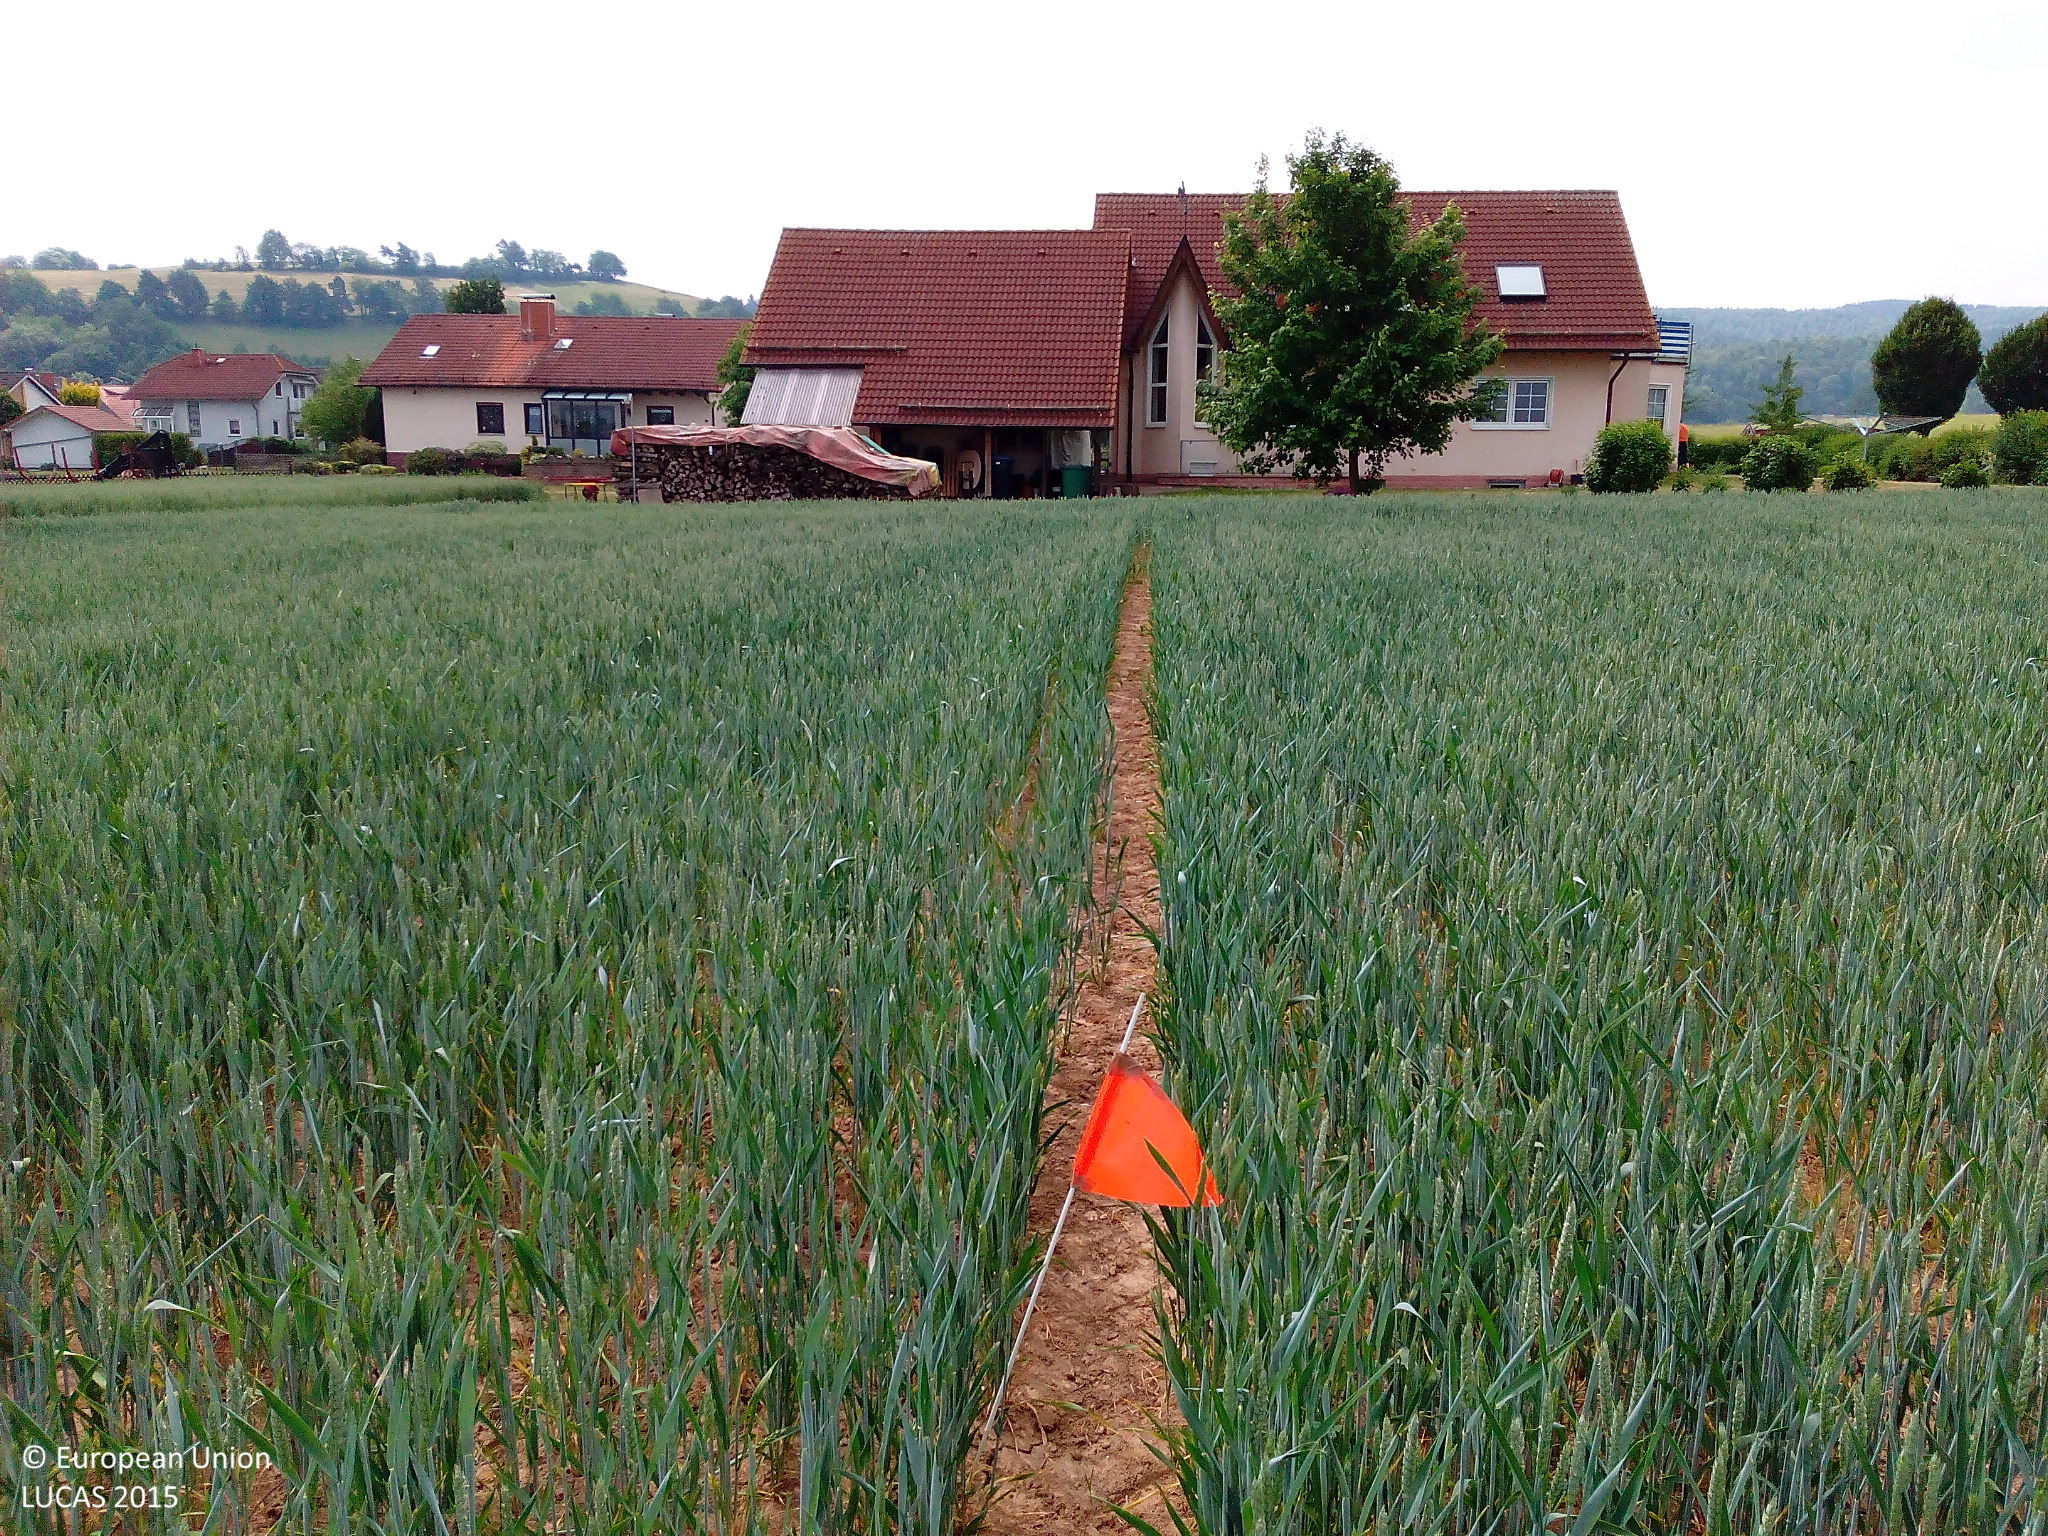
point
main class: Cropland
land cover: Common wheat
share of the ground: > 75 %
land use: Agriculture (excluding fallow land and kitchen gardens)
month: June
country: DE
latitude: 51.0108
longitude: 9.6438
